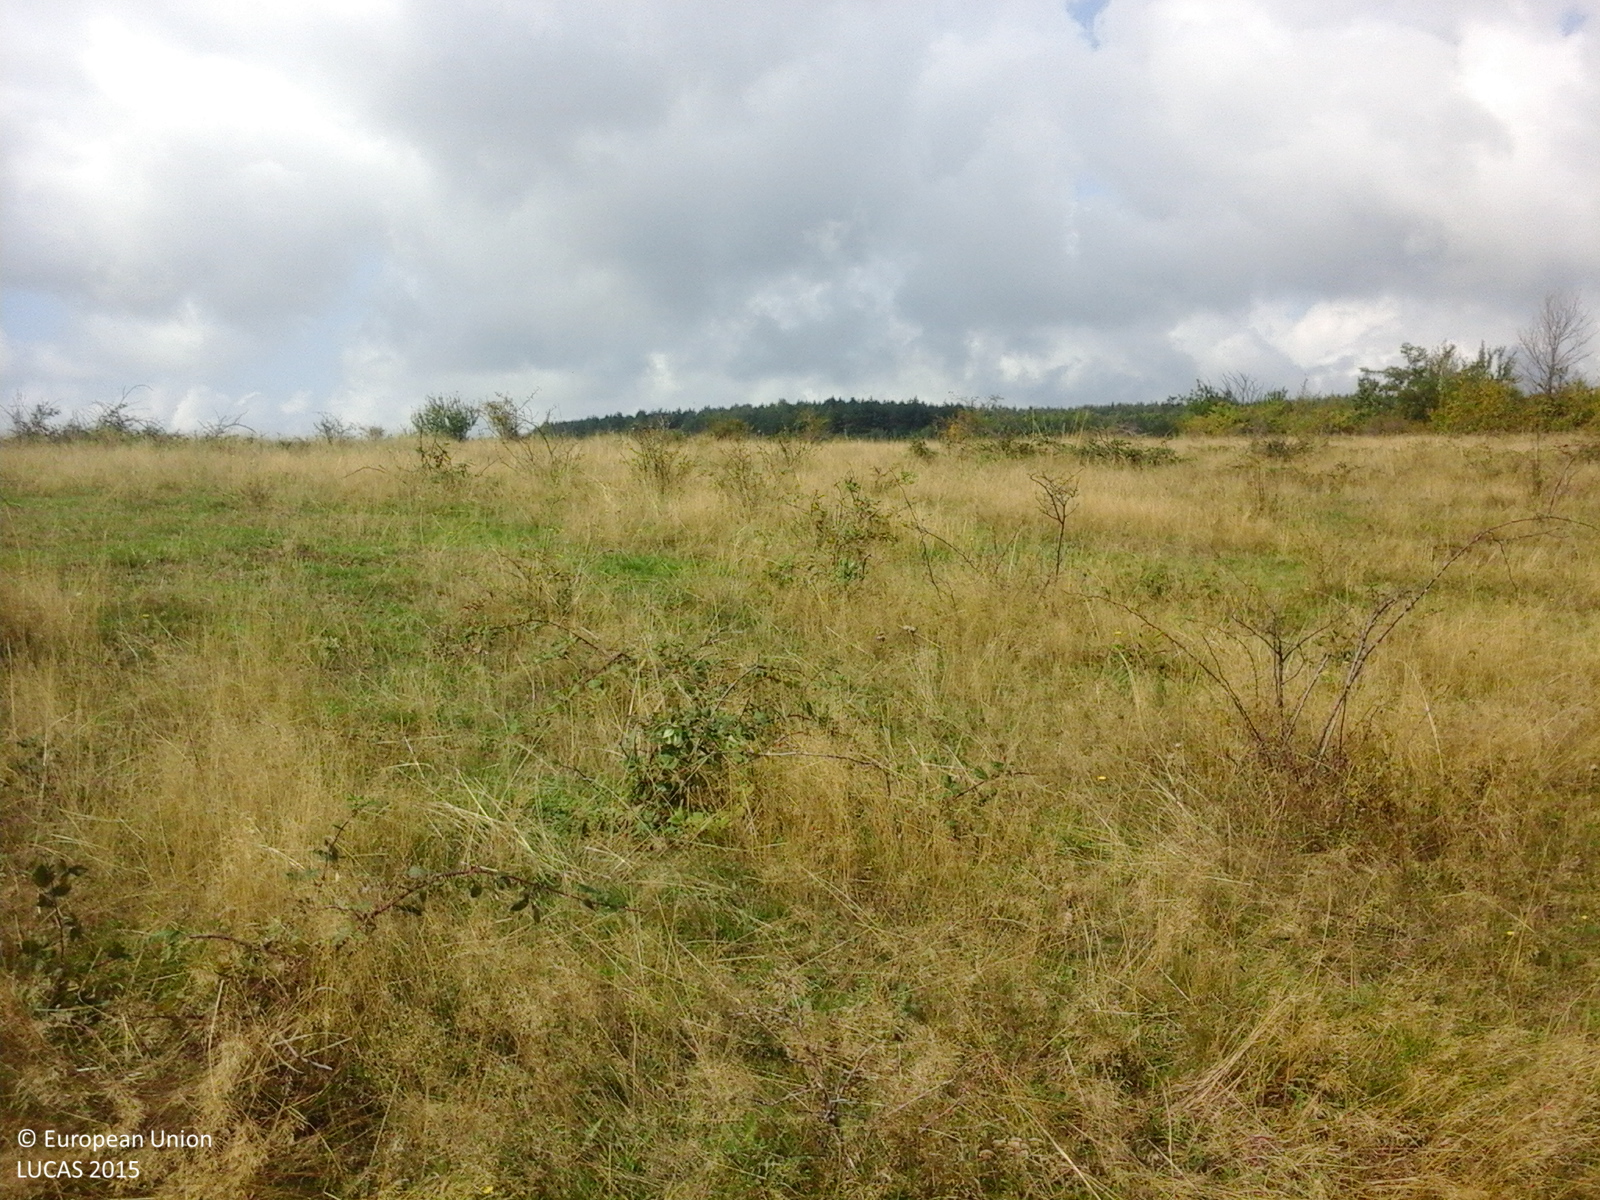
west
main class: Grassland
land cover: Grassland with sparse tree/shrub cover
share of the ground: > 75 %
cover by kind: herbaceous plants 95 %, broadleaved forest trees 5 %
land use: Agriculture (excluding fallow land and kitchen gardens)
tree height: > 5 m
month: September
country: RO
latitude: 45.1502
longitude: 23.4509
